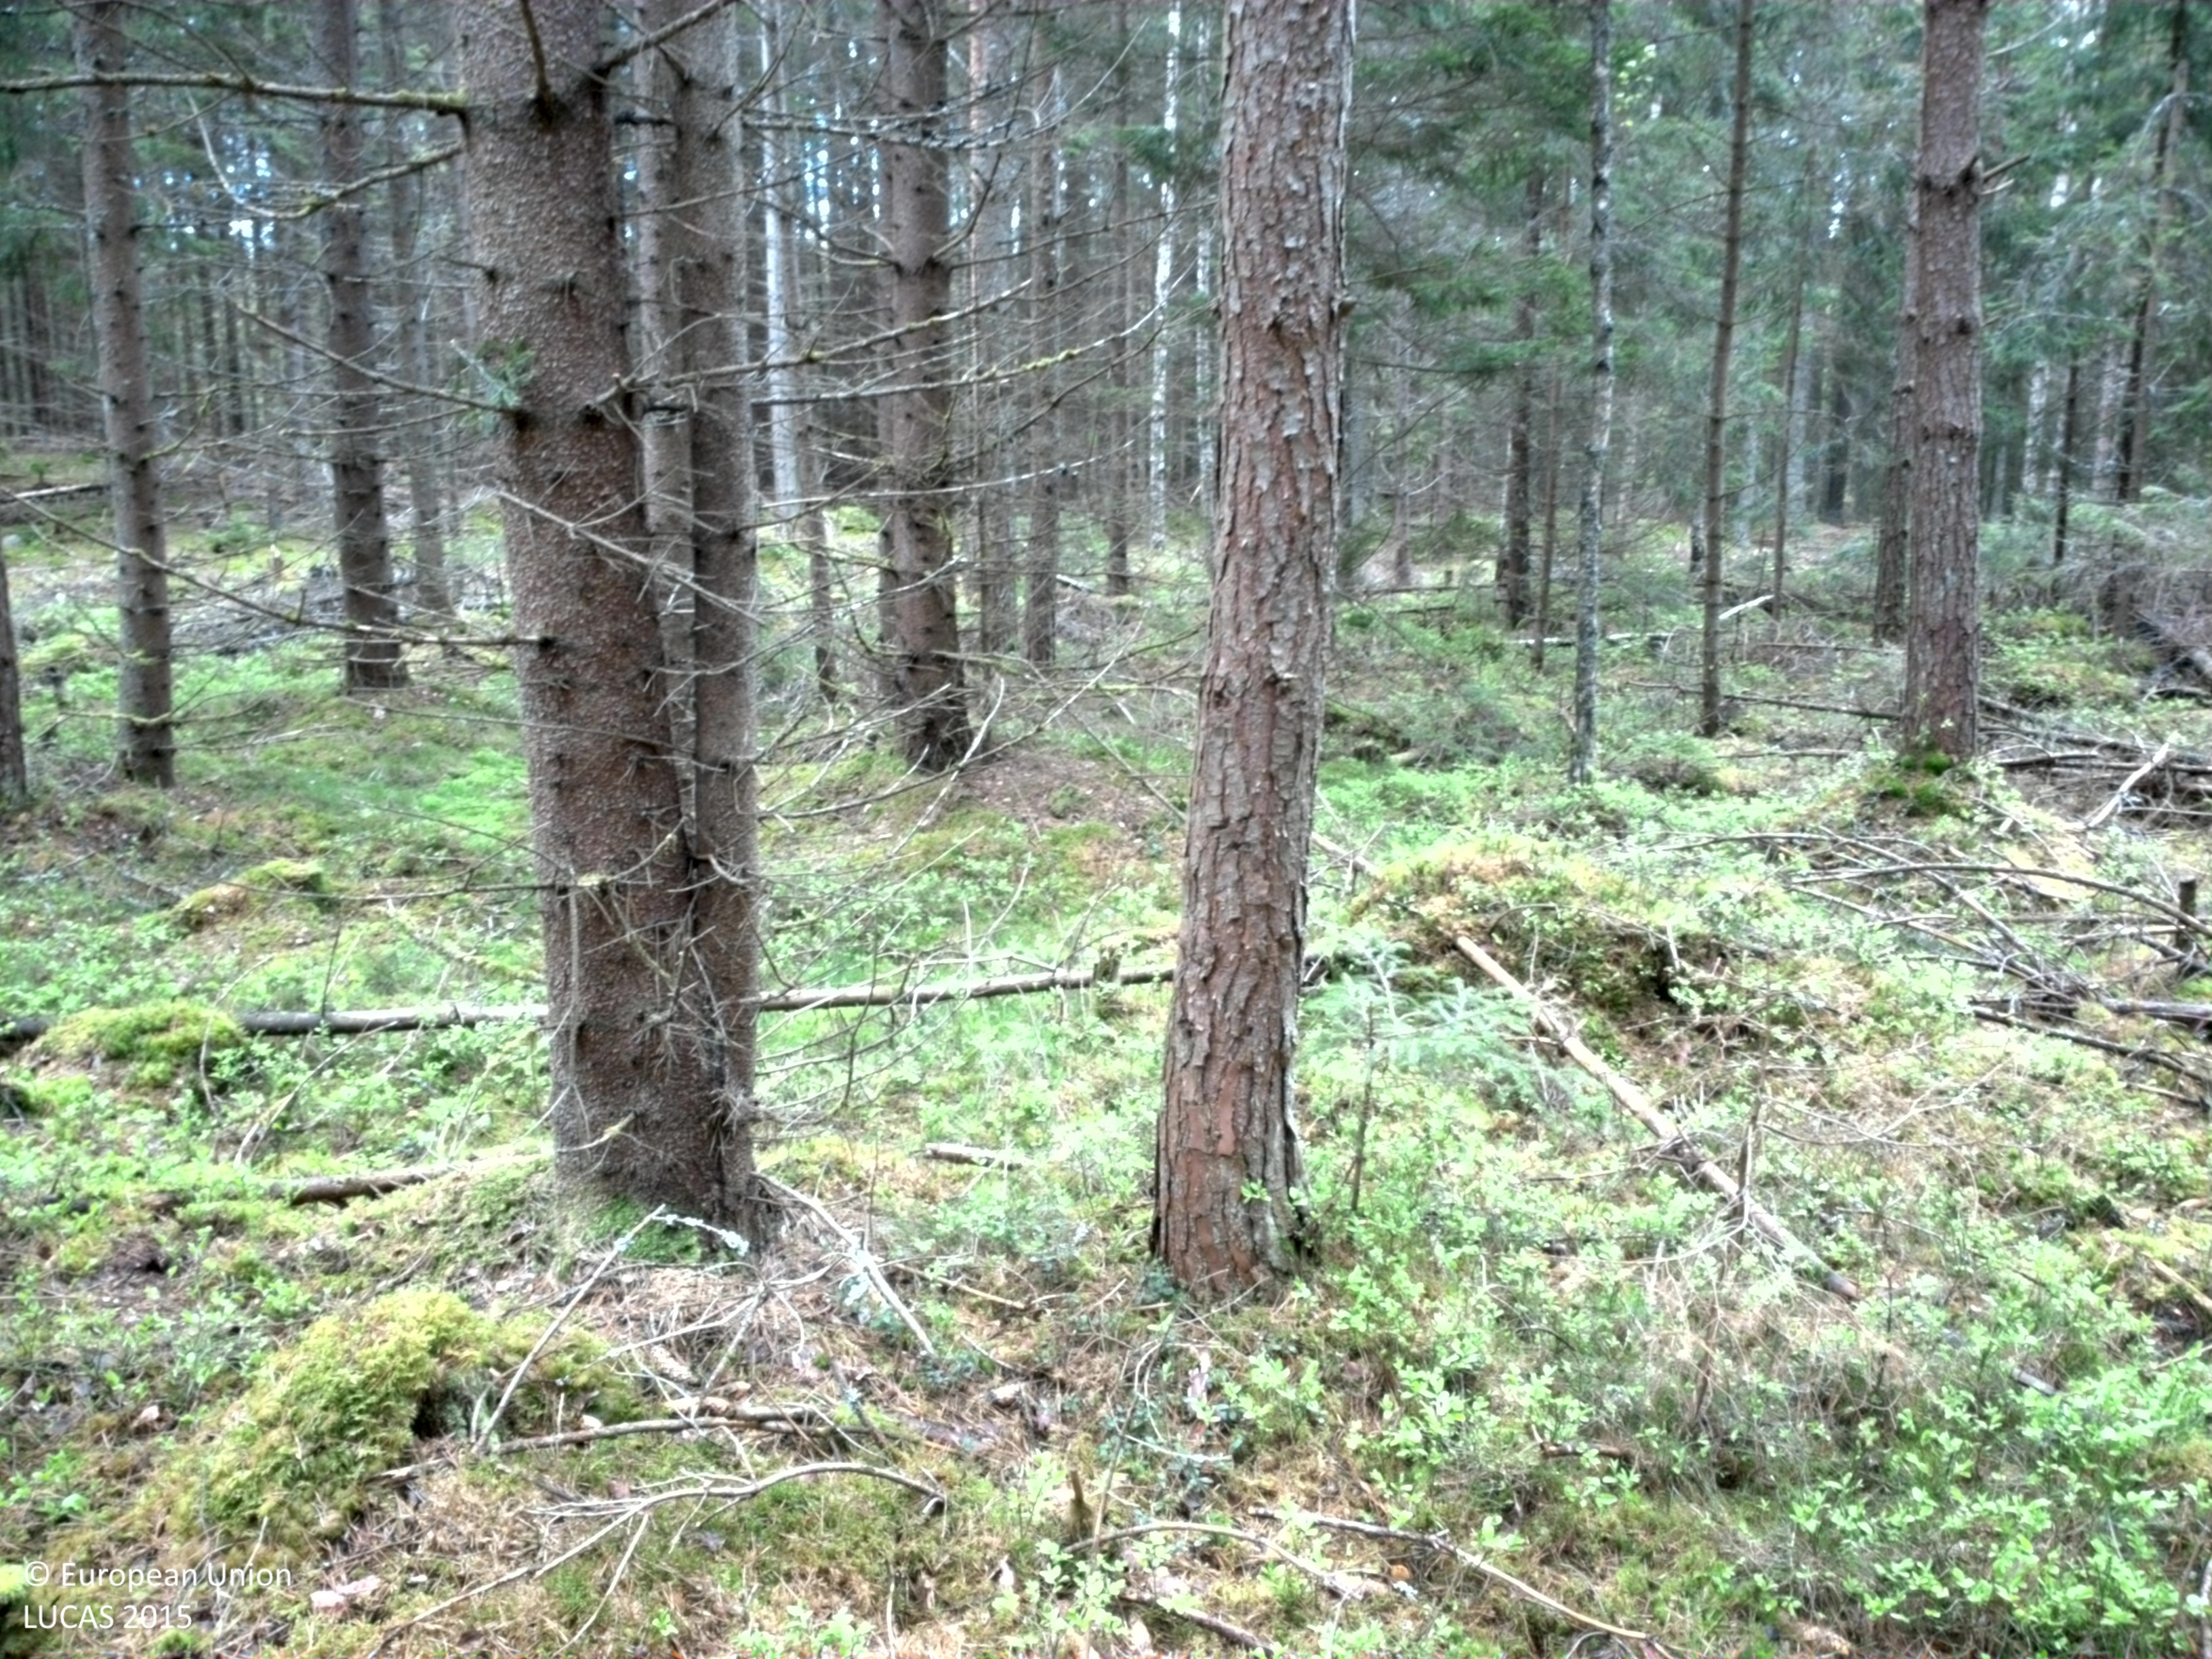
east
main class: Woodland
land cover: Spruce dominated coniferous woodland
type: boreal forest
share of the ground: > 75 %
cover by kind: coniferous forest trees 85 %, broadleaved forest trees 10 %, lichens and mosses 5 %
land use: Forestry
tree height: > 5 m
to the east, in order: Spruce dominated coniferous woodland; Paved roads, cycling and walking lanes; Spruce dominated coniferous woodland
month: May
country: SE
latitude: 56.5394
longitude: 15.4793
